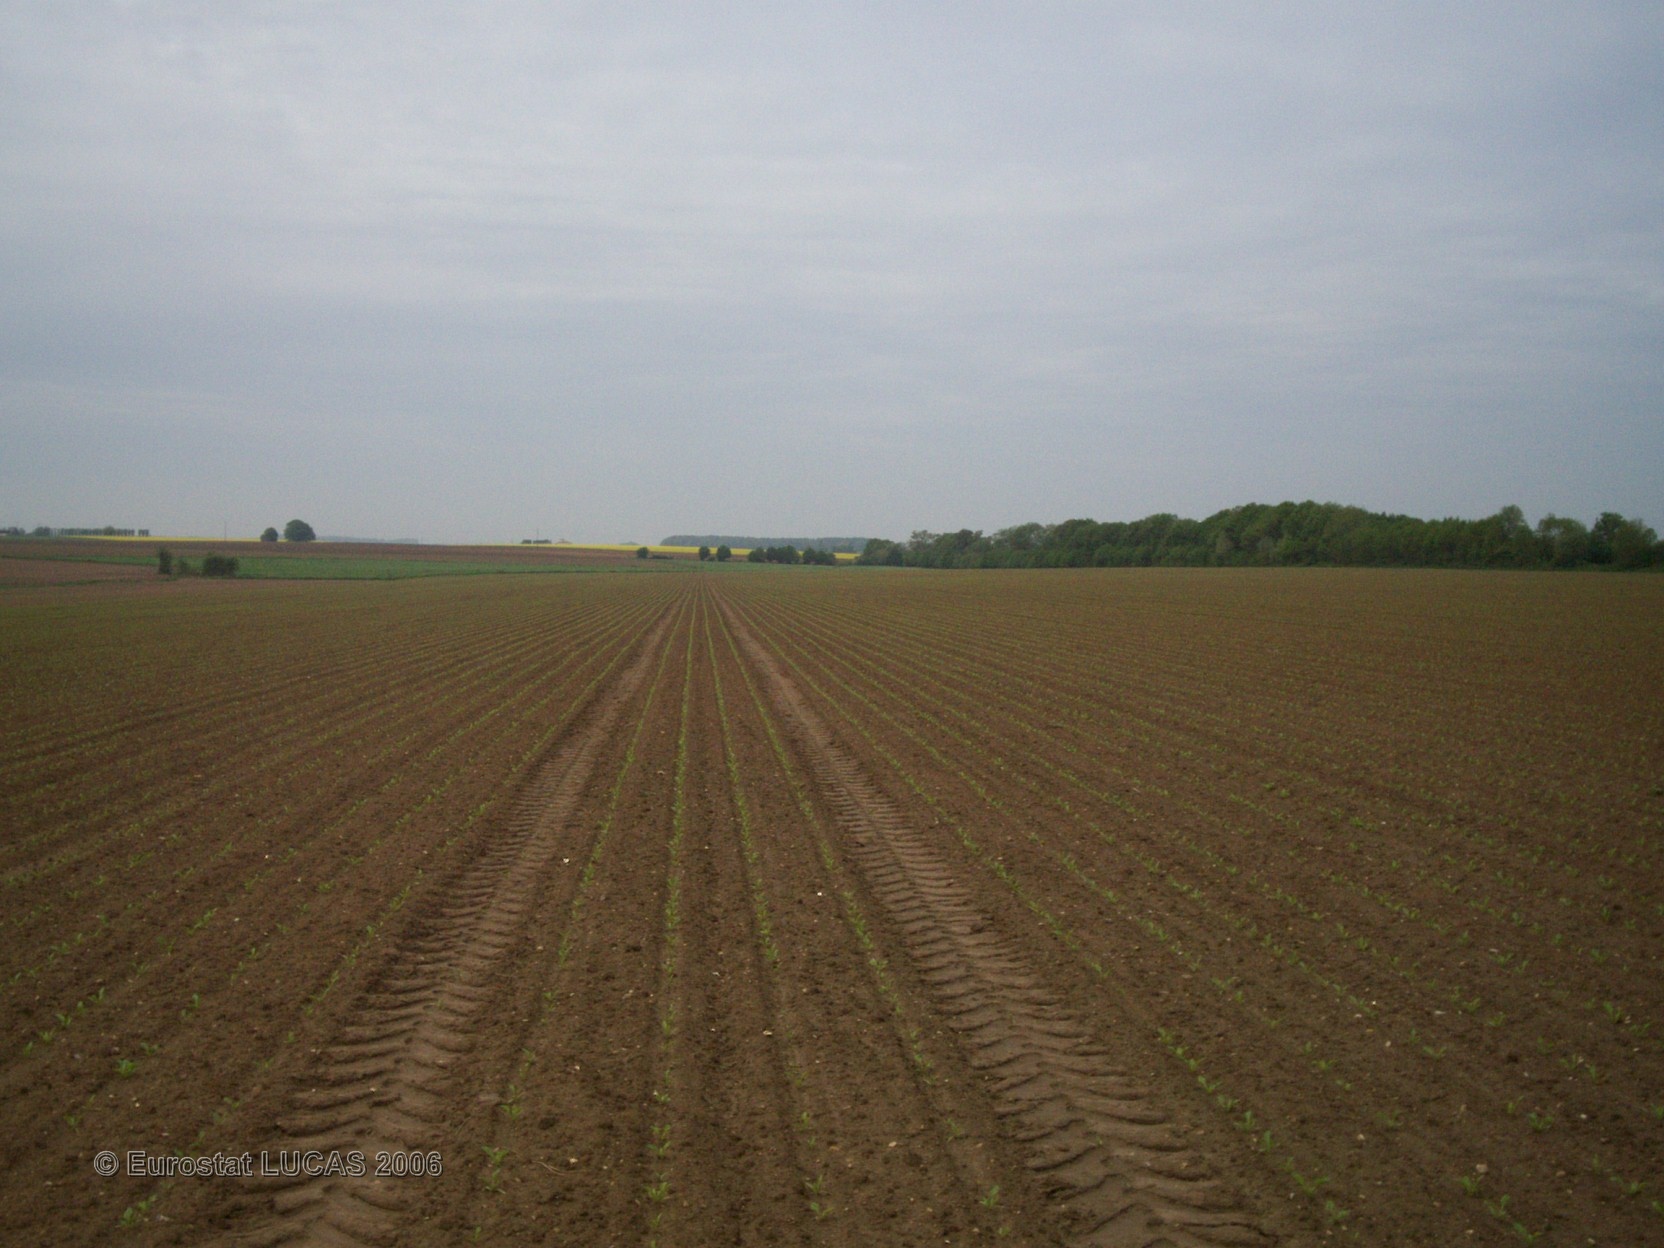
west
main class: Cropland
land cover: Sugar beet
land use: Agriculture (excluding fallow land and kitchen gardens)
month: May
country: FR
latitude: 49.9399
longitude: 3.7372
